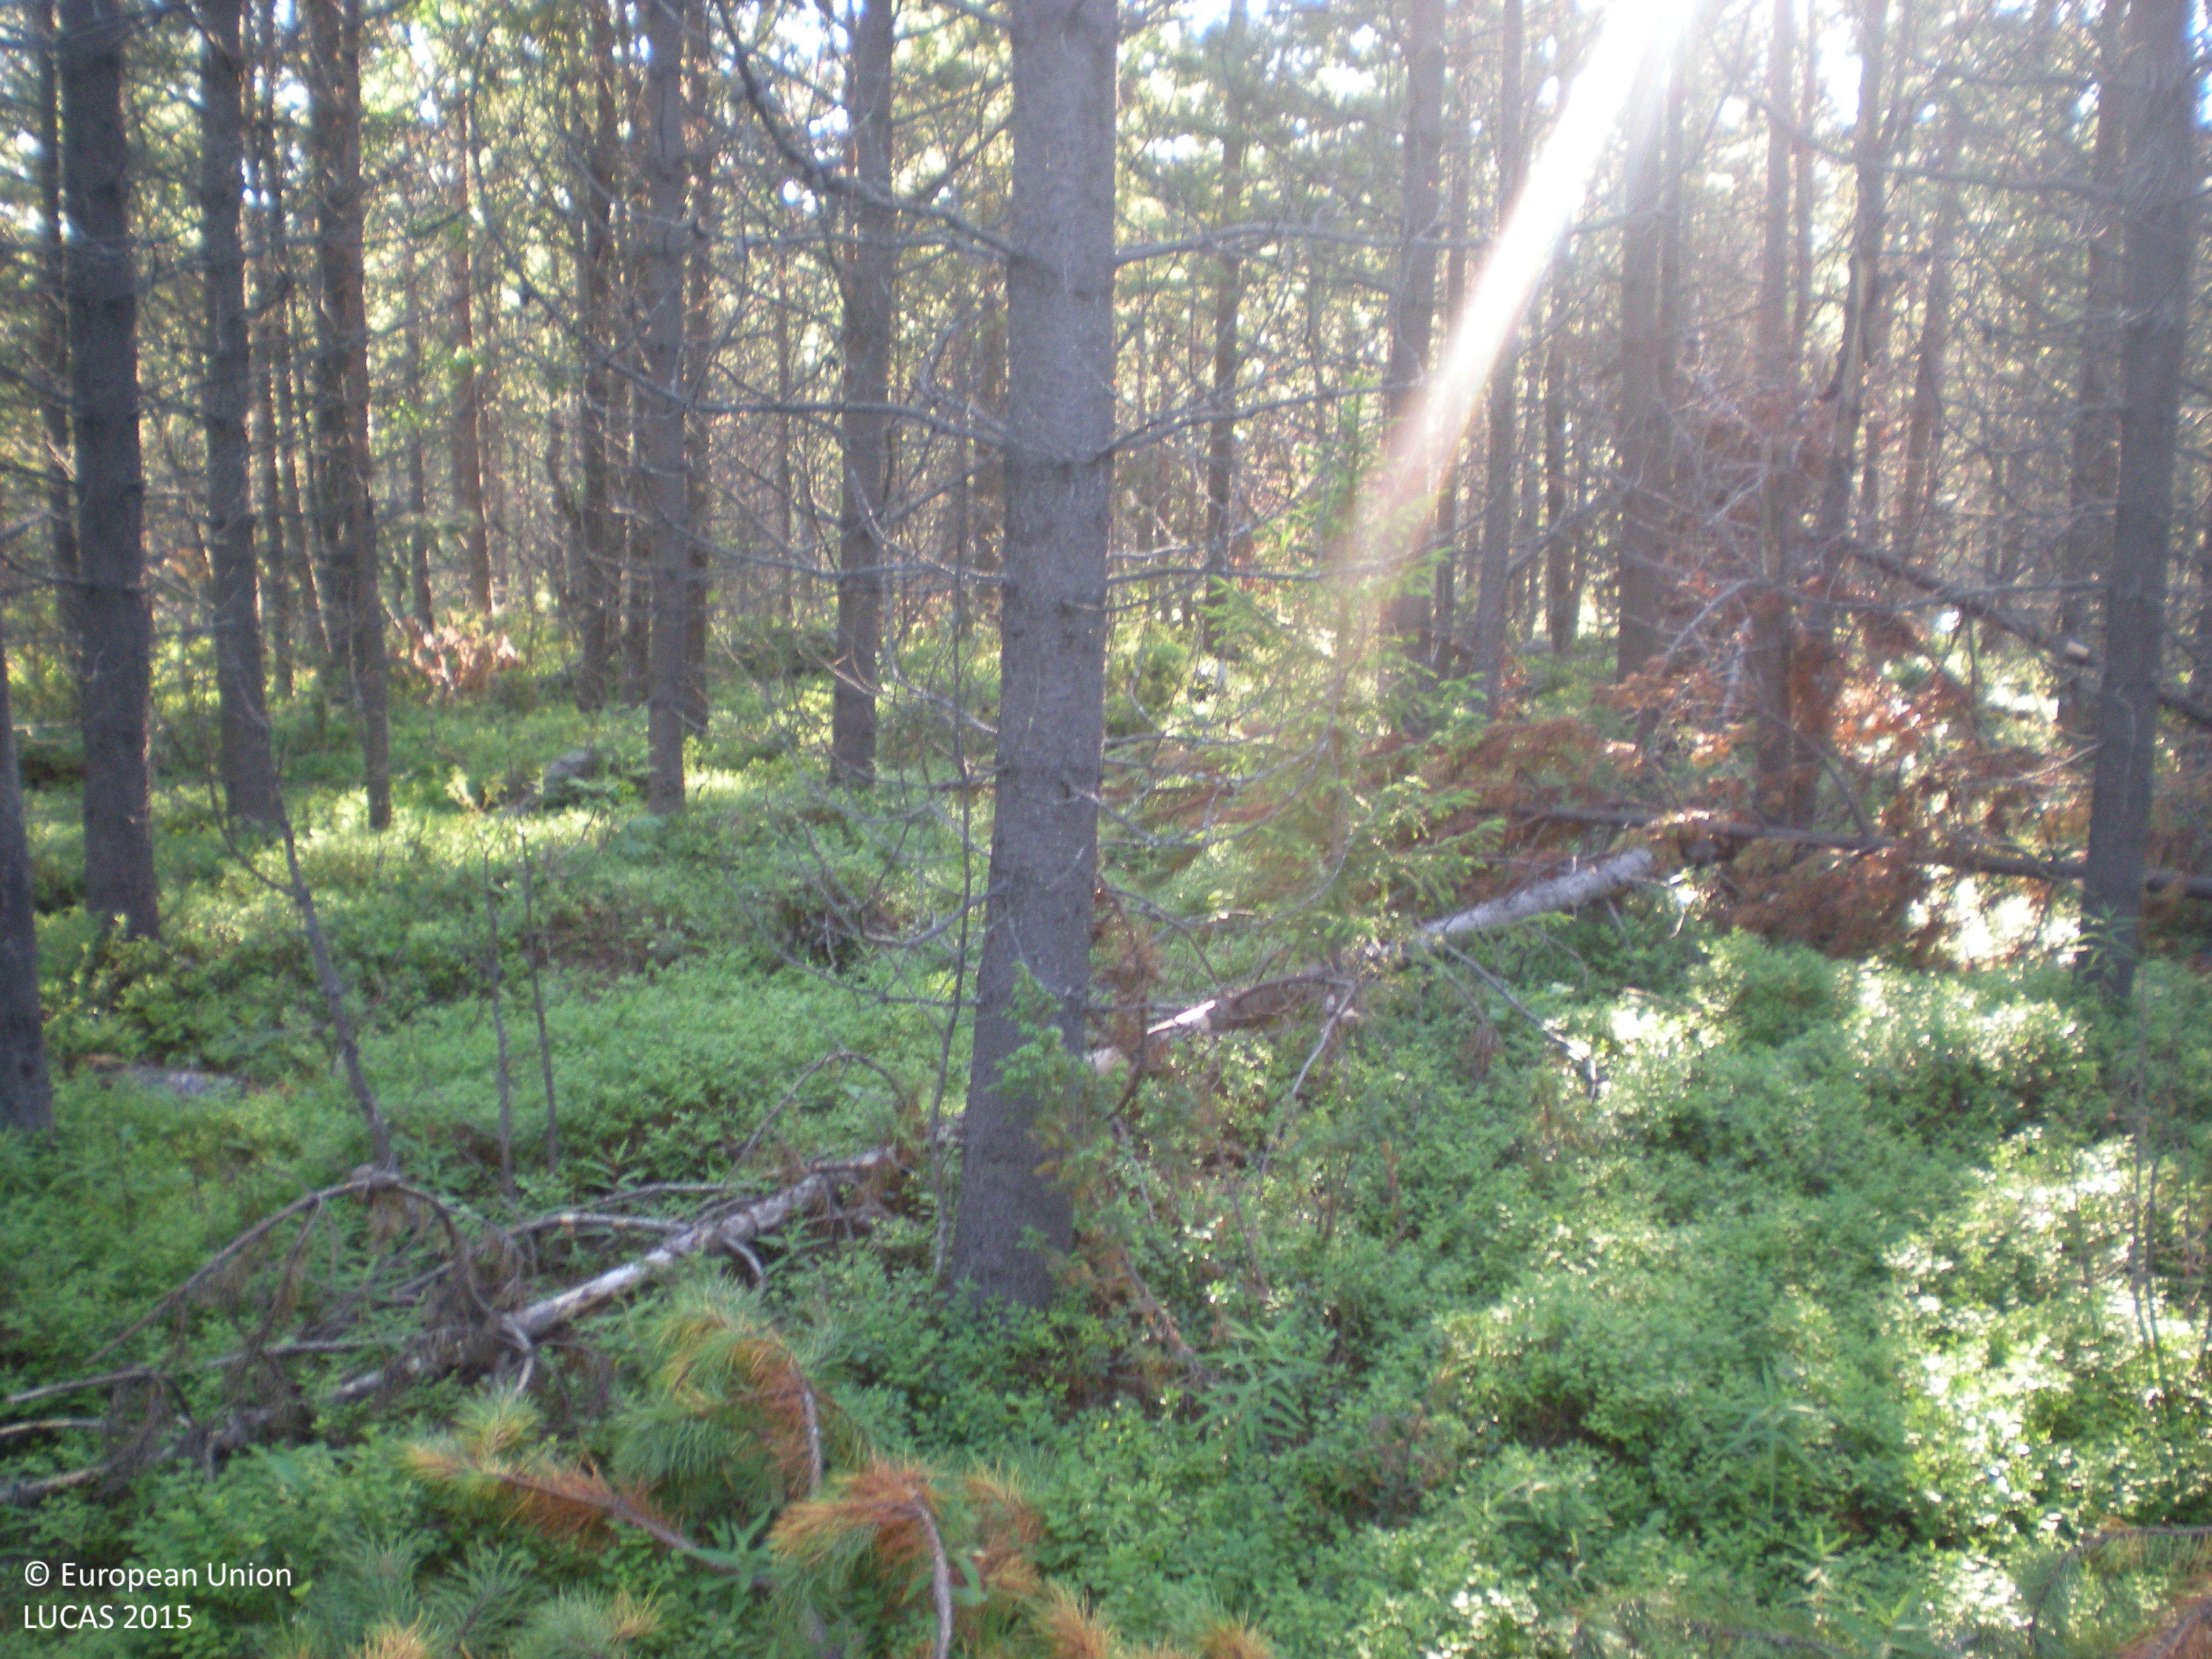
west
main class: Woodland
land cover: Pine dominated coniferous woodland
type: exotic forest
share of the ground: 50 - 75 %
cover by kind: coniferous forest trees 75 %, shrubs 20 %, consolidated bare surface 5 %
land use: Forestry
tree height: > 5 m
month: August
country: SE
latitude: 66.2672
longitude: 18.0360
